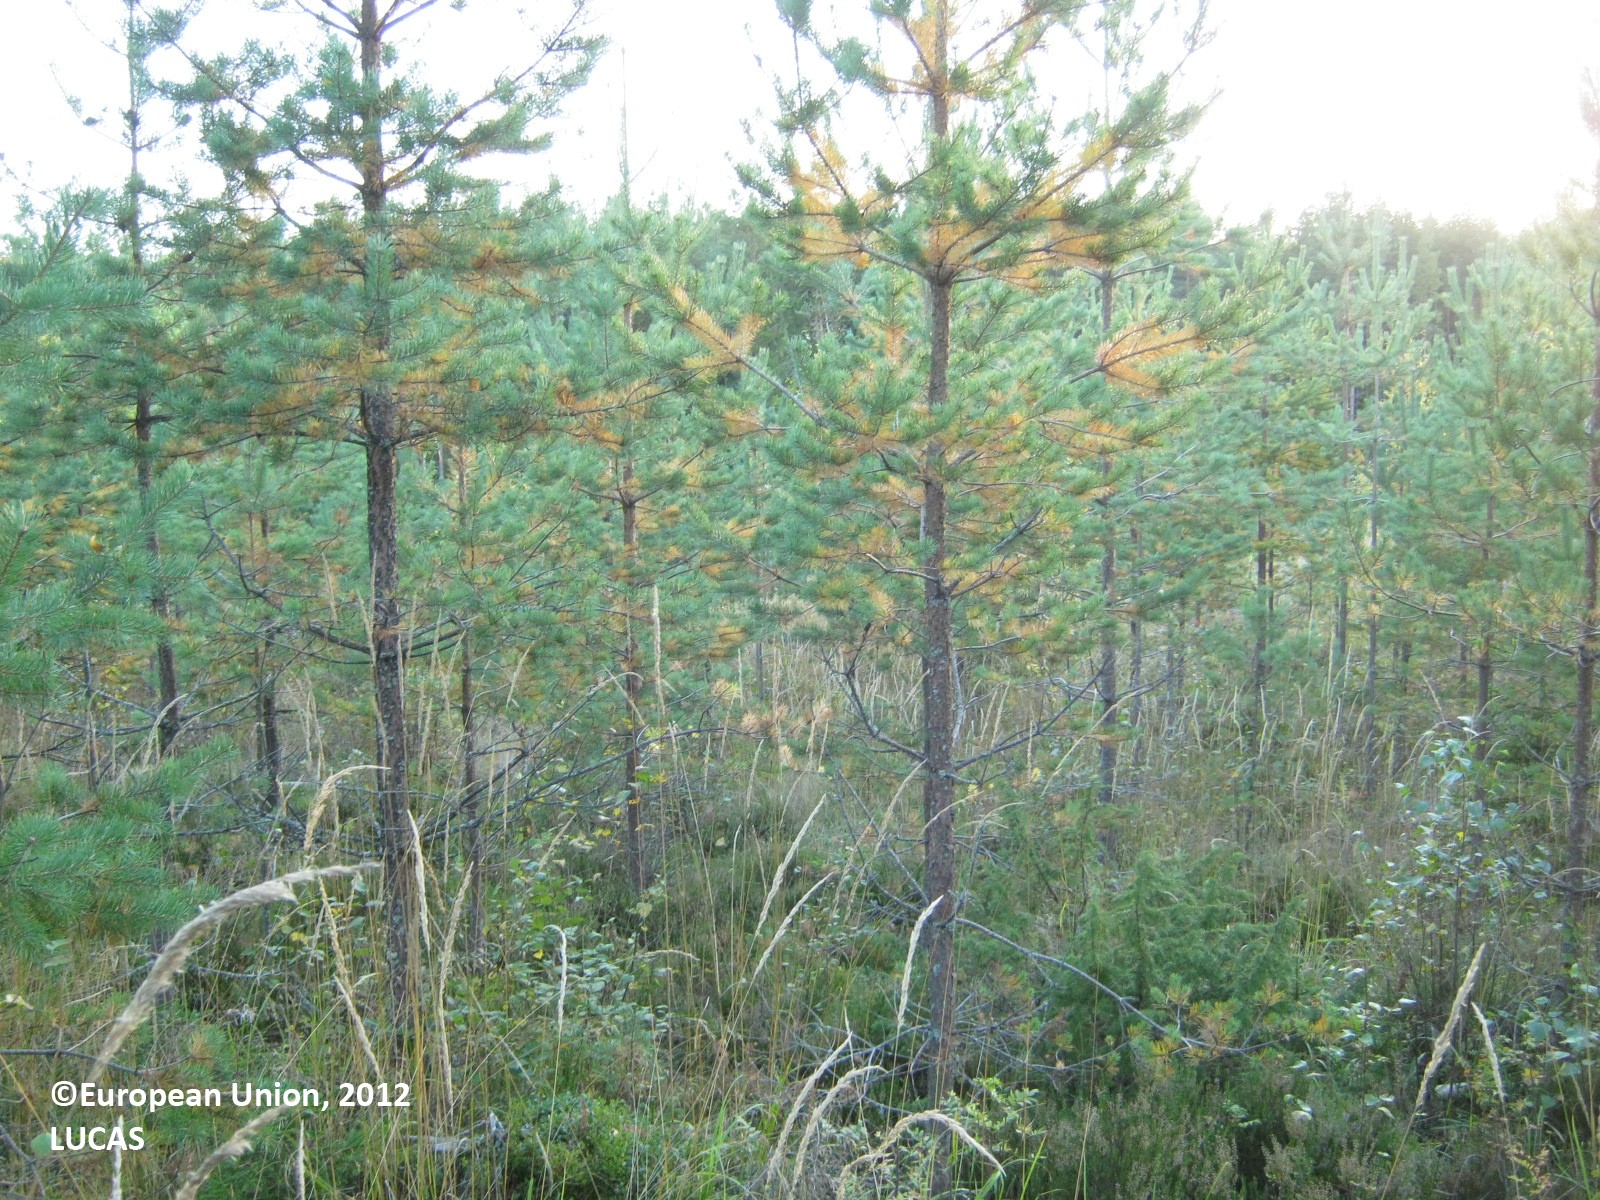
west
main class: Woodland
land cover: Pine dominated coniferous woodland
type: boreal forest
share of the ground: > 75 %
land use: Forestry
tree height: < 5 m
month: September
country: FI
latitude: 60.7750
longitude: 27.9547
